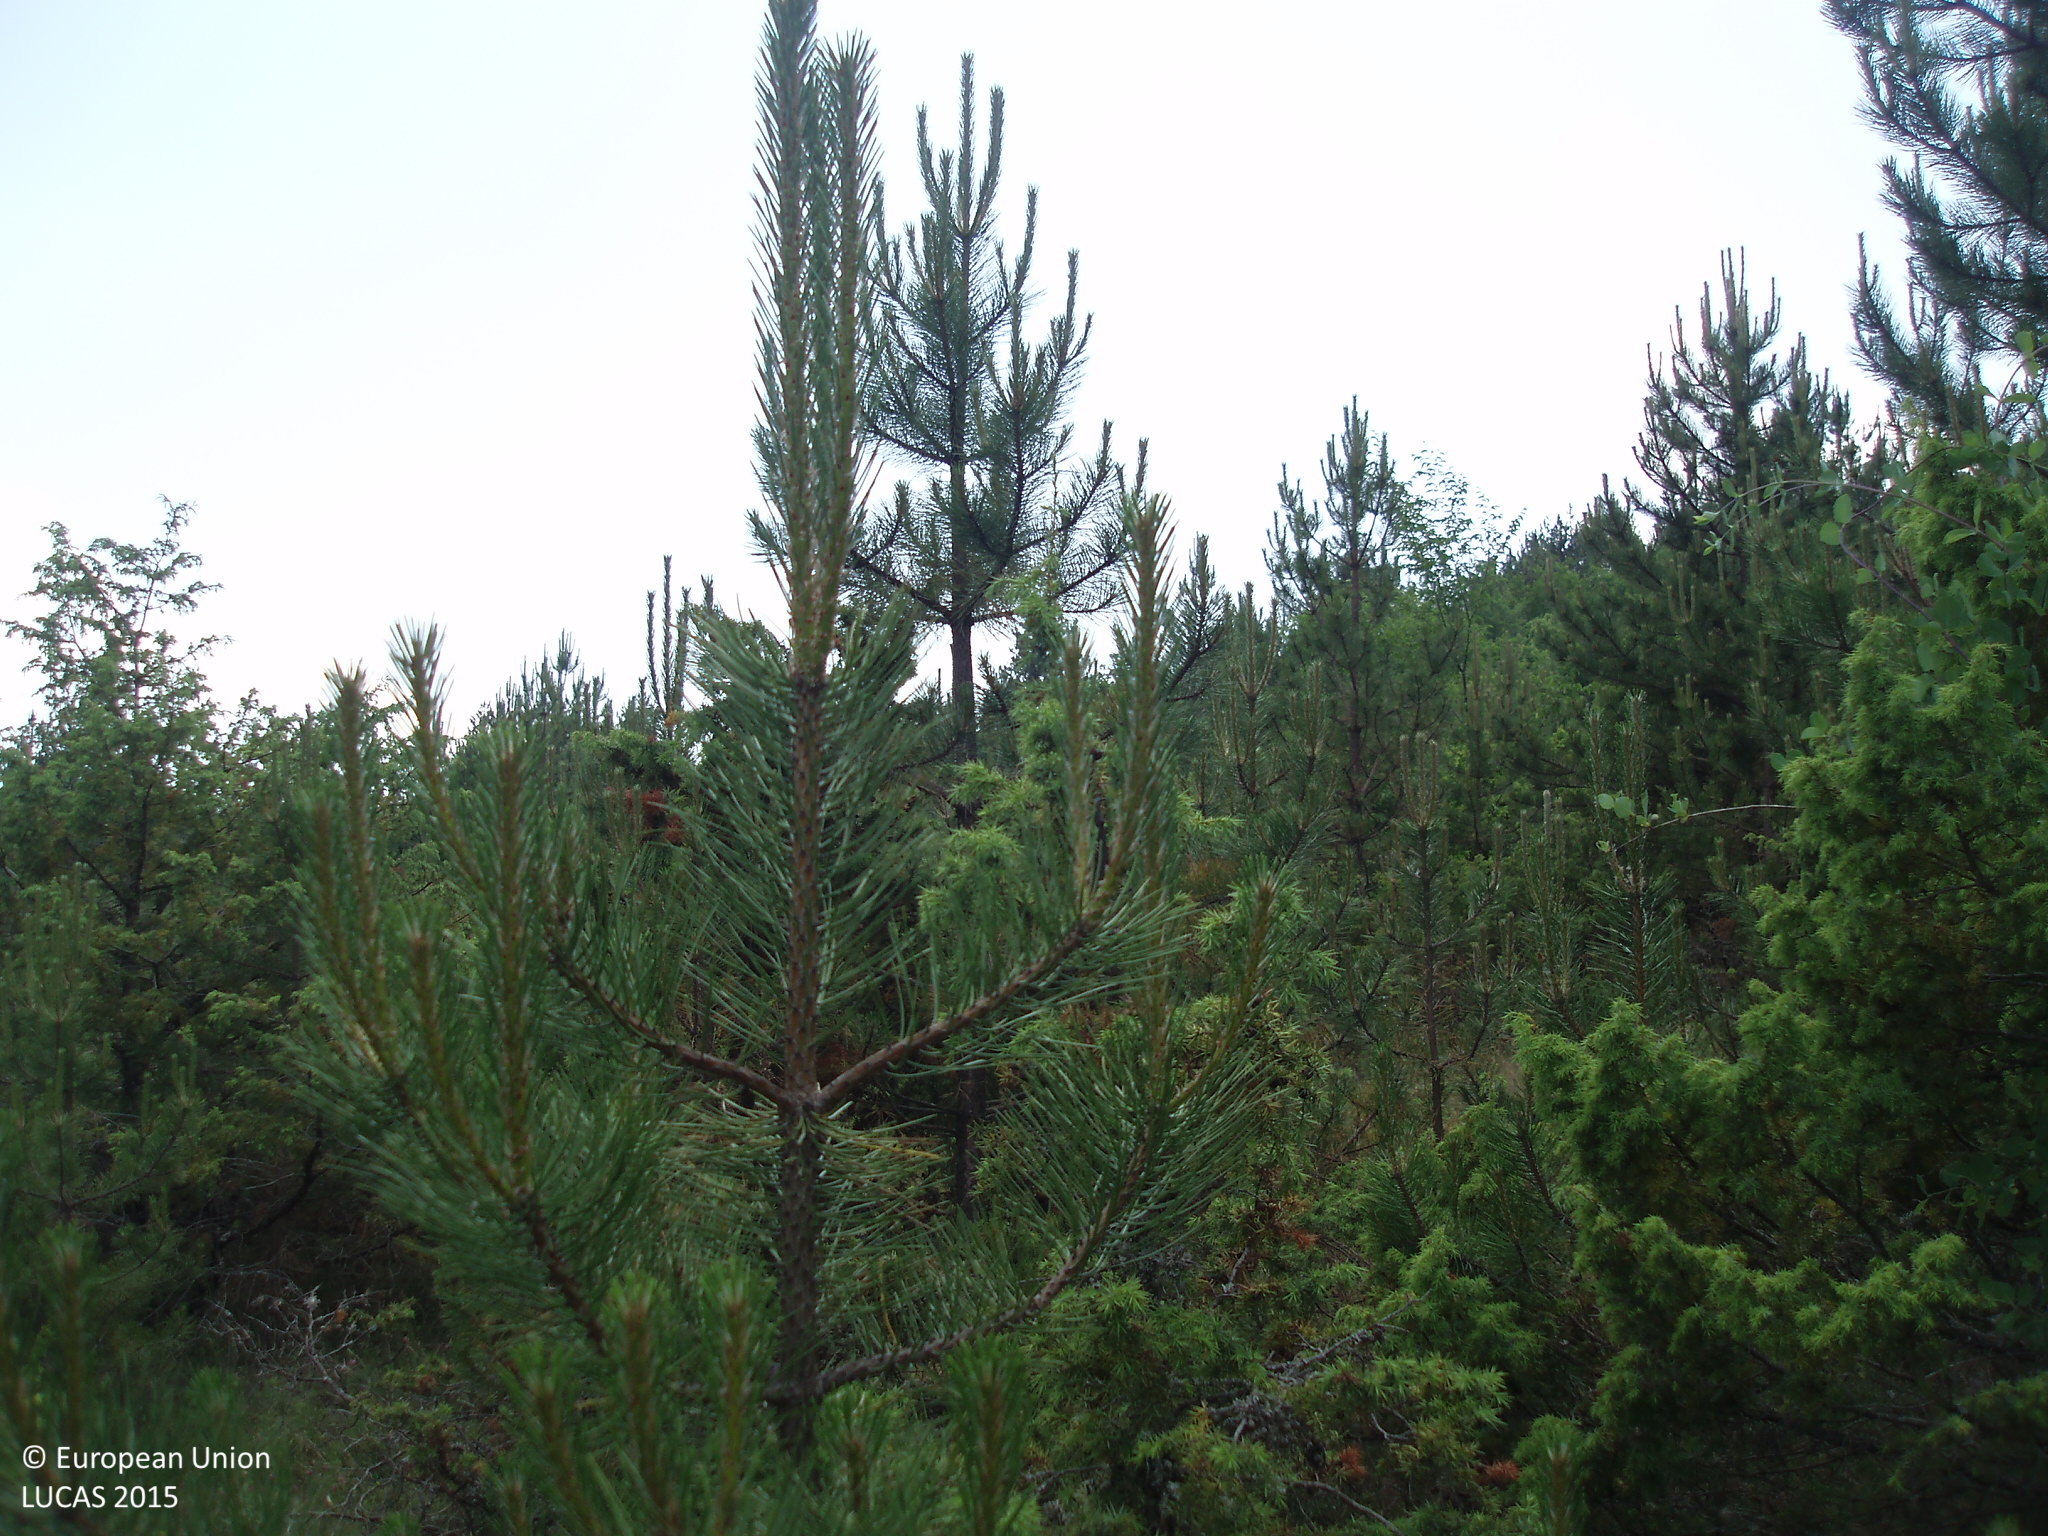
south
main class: Woodland
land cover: Other mixed woodland
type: hemiboreal forest and nemoral coniferous forest and mixed broadleaved-coniferous forest
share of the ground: > 75 %
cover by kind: coniferous forest trees 75 %, broadleaved forest trees 25 %
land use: Forestry
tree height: > 5 m
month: June
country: BG
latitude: 41.4073
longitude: 23.6989
